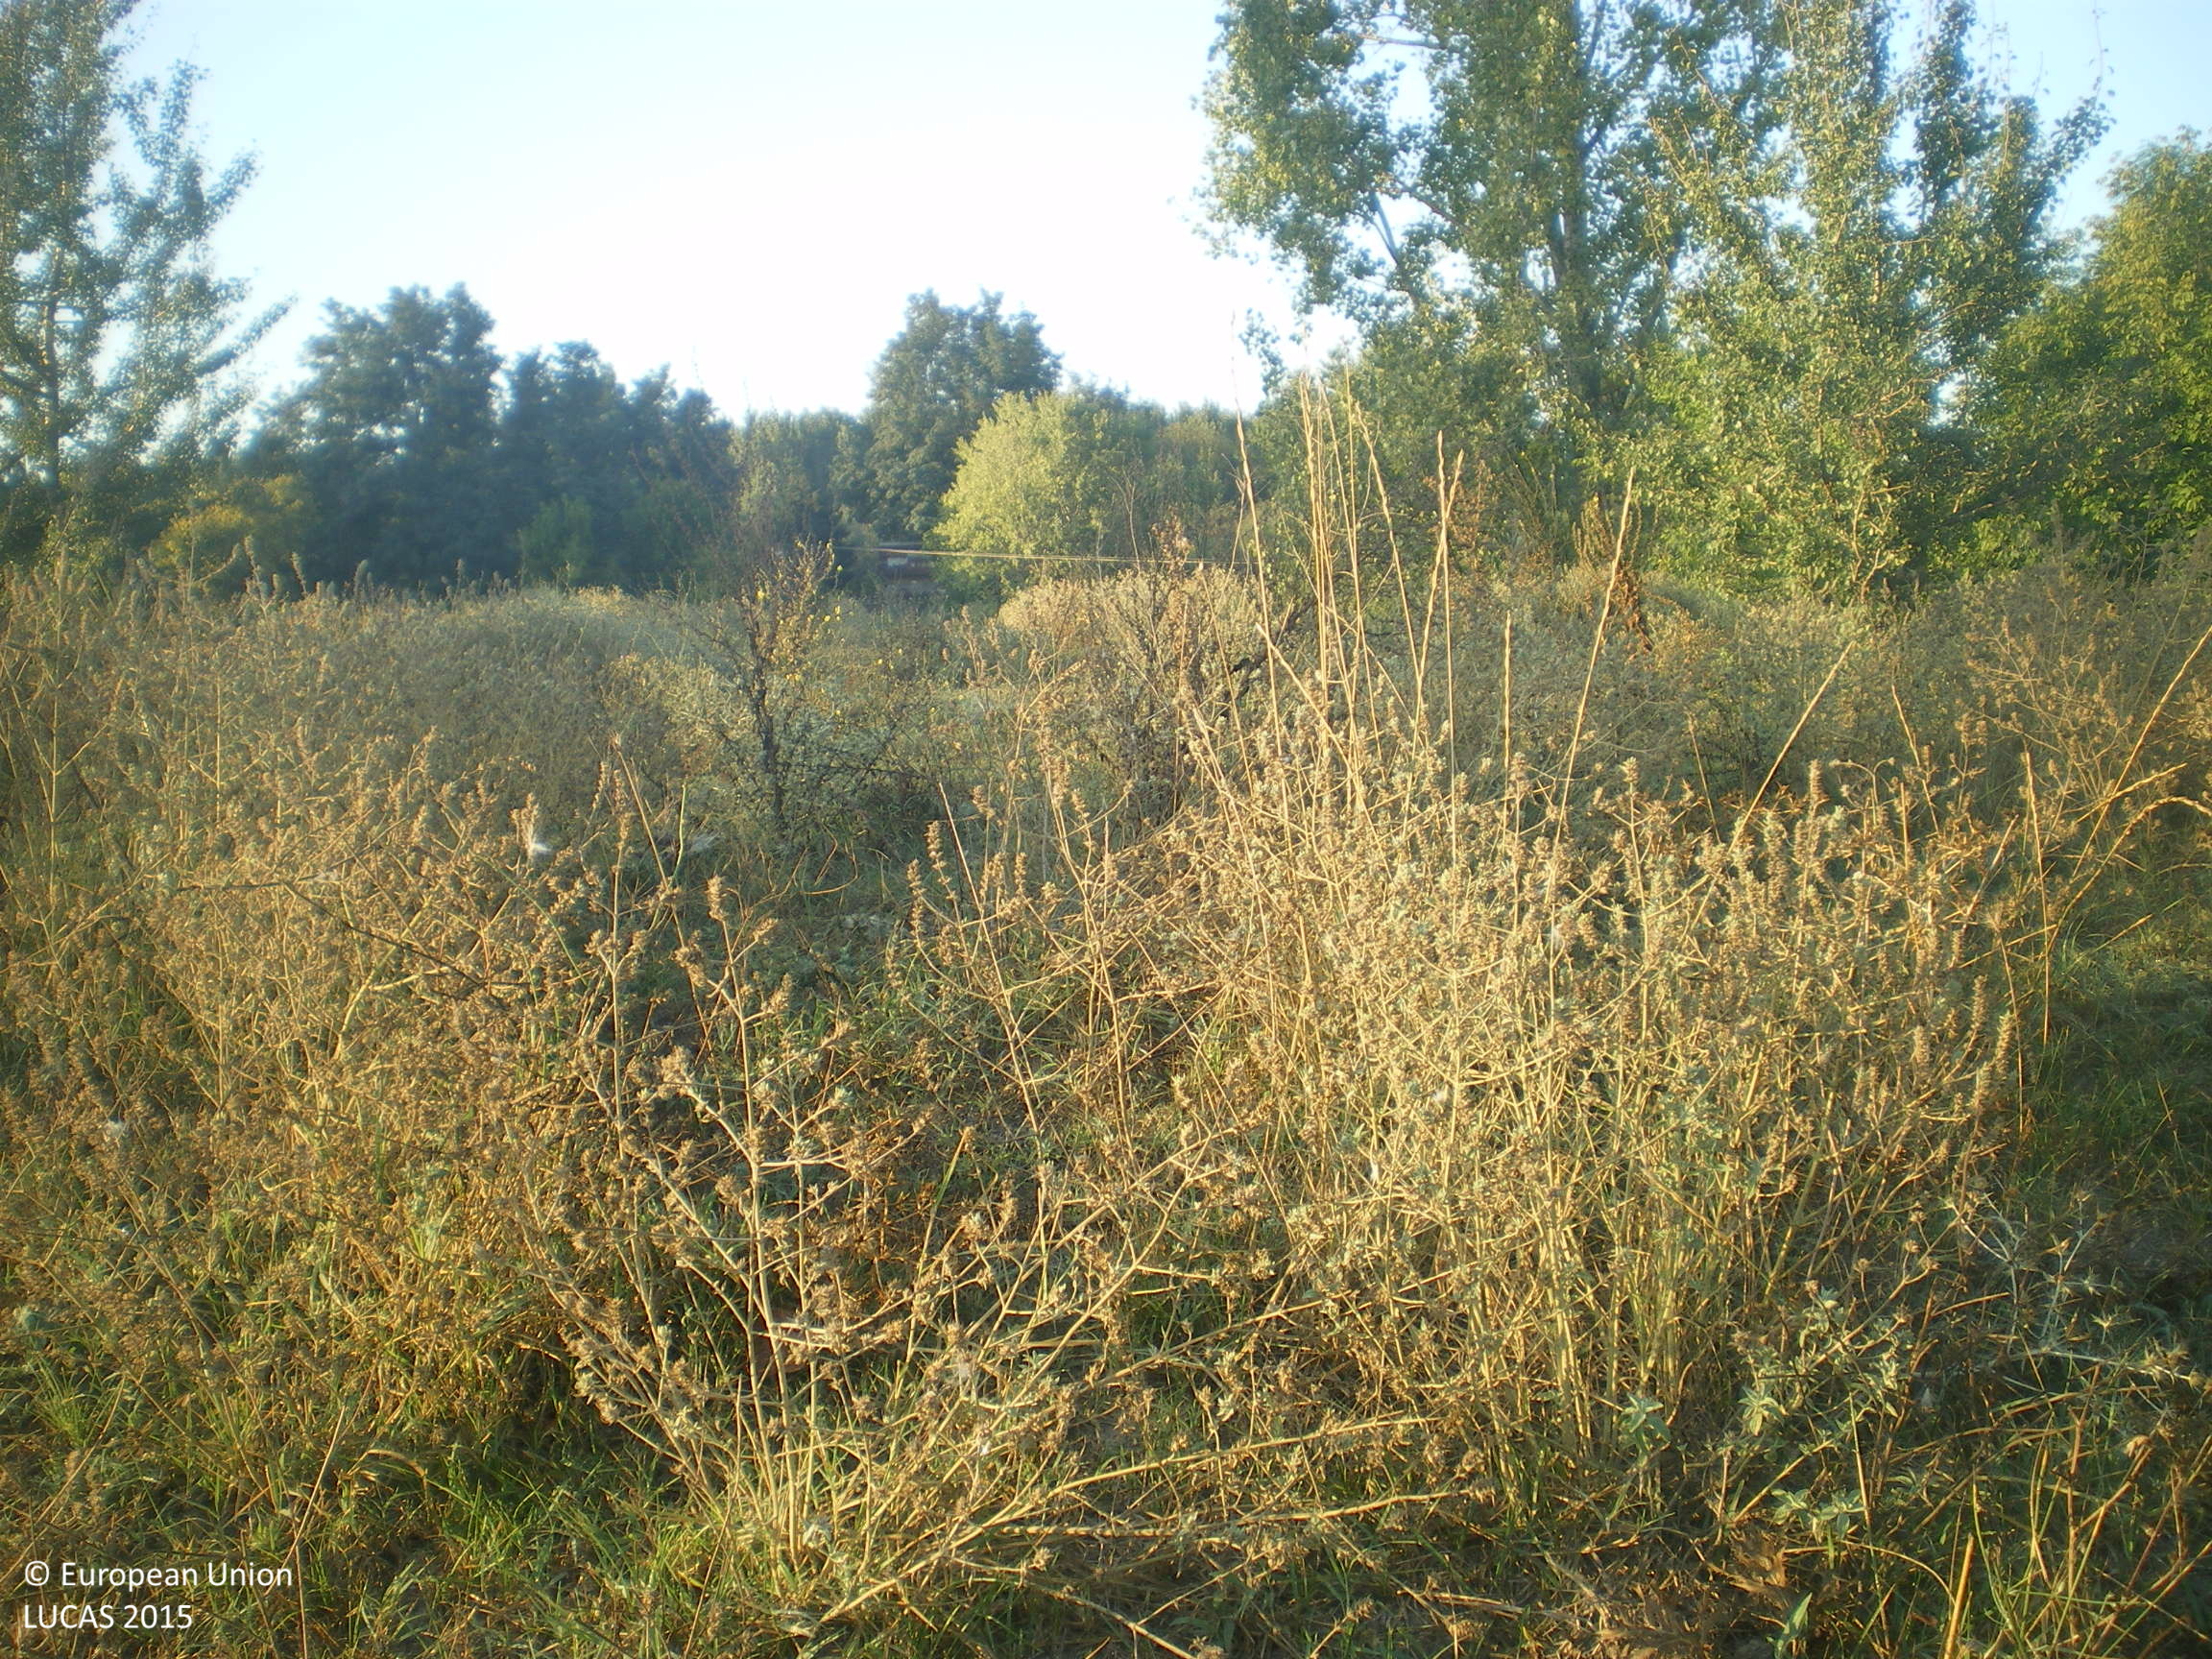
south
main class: Grassland
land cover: Grassland with sparse tree/shrub cover
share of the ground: > 75 %
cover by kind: herbaceous plants 90 %, broadleaved forest trees 5 %, shrubs 5 %
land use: Agriculture (excluding fallow land and kitchen gardens)
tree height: > 5 m
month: August
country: BG
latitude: 42.0380
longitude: 25.8605
